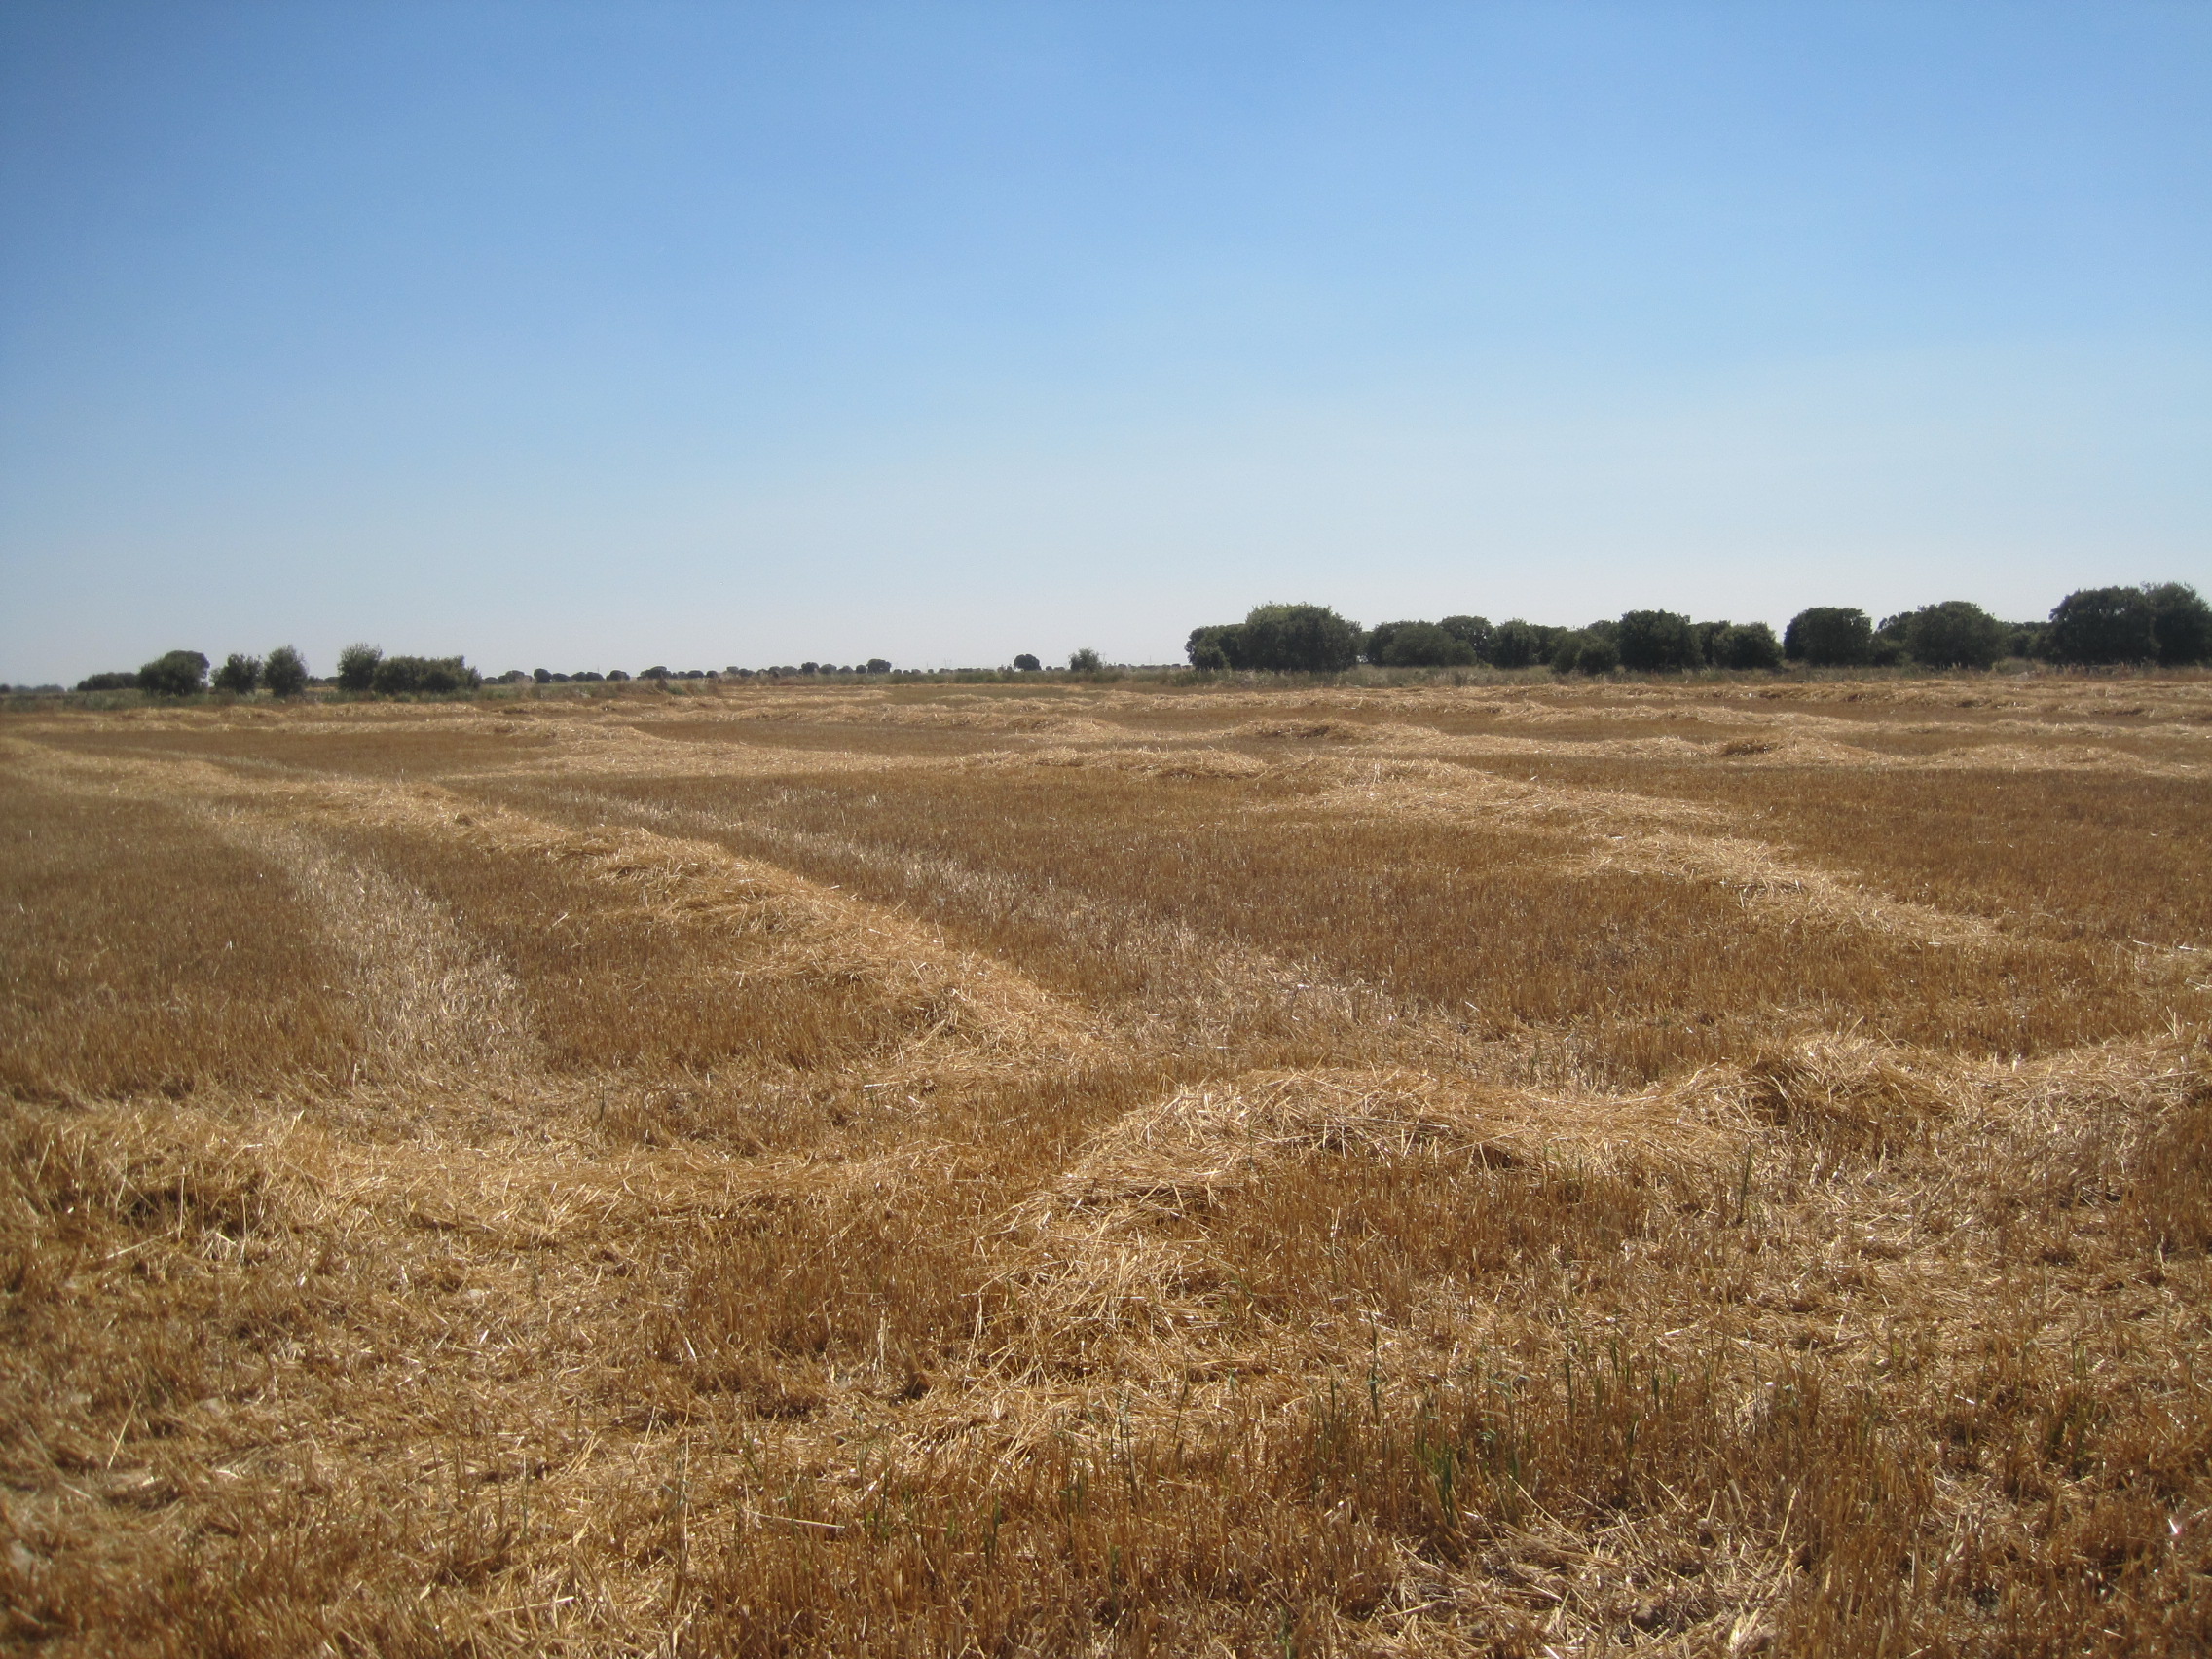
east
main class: Cropland
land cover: Oats
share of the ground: < 10 %
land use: Agriculture (excluding fallow land and kitchen gardens)
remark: Harvested field
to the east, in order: Oats; Grassland with sparse tree/shrub cover; Oats; Grassland with sparse tree/shrub cover; Oats
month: July
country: ES
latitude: 41.9232
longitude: -4.6988
